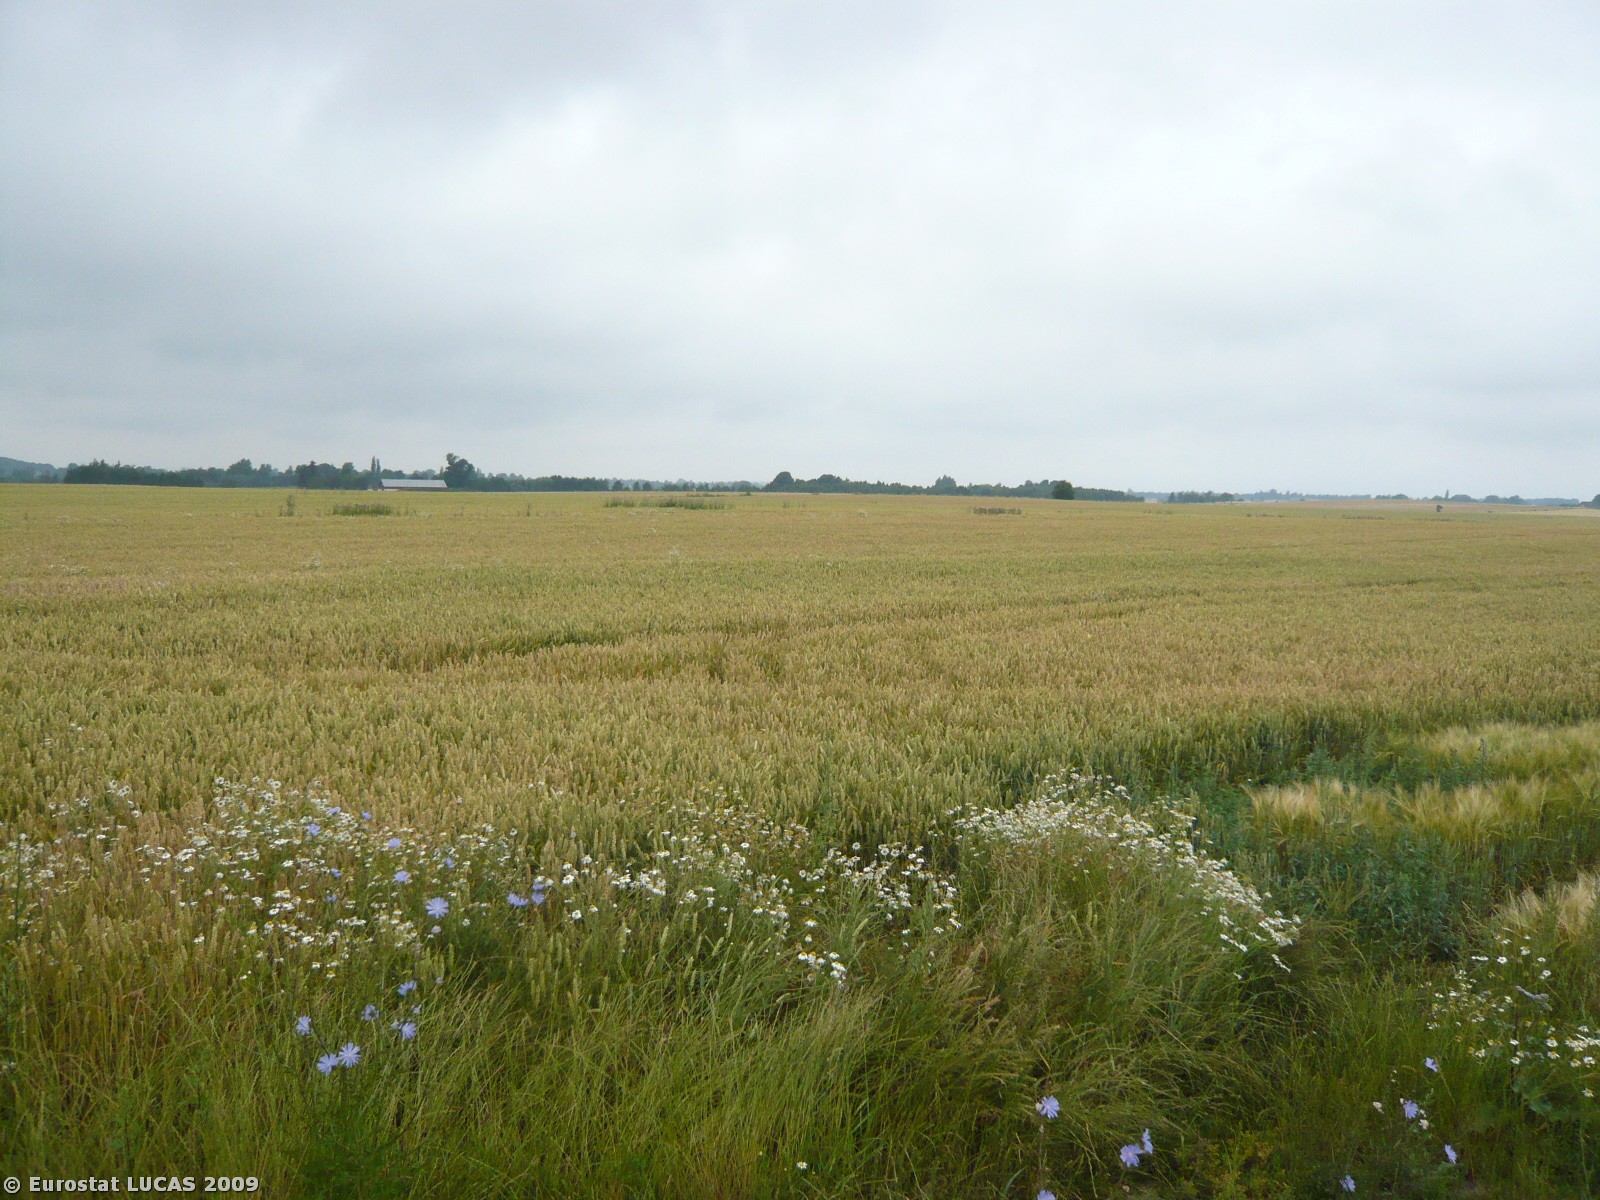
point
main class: Cropland
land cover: Common wheat
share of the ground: > 75 %
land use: Agriculture (excluding fallow land and kitchen gardens)
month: July
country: DK
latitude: 55.6884
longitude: 11.8912
